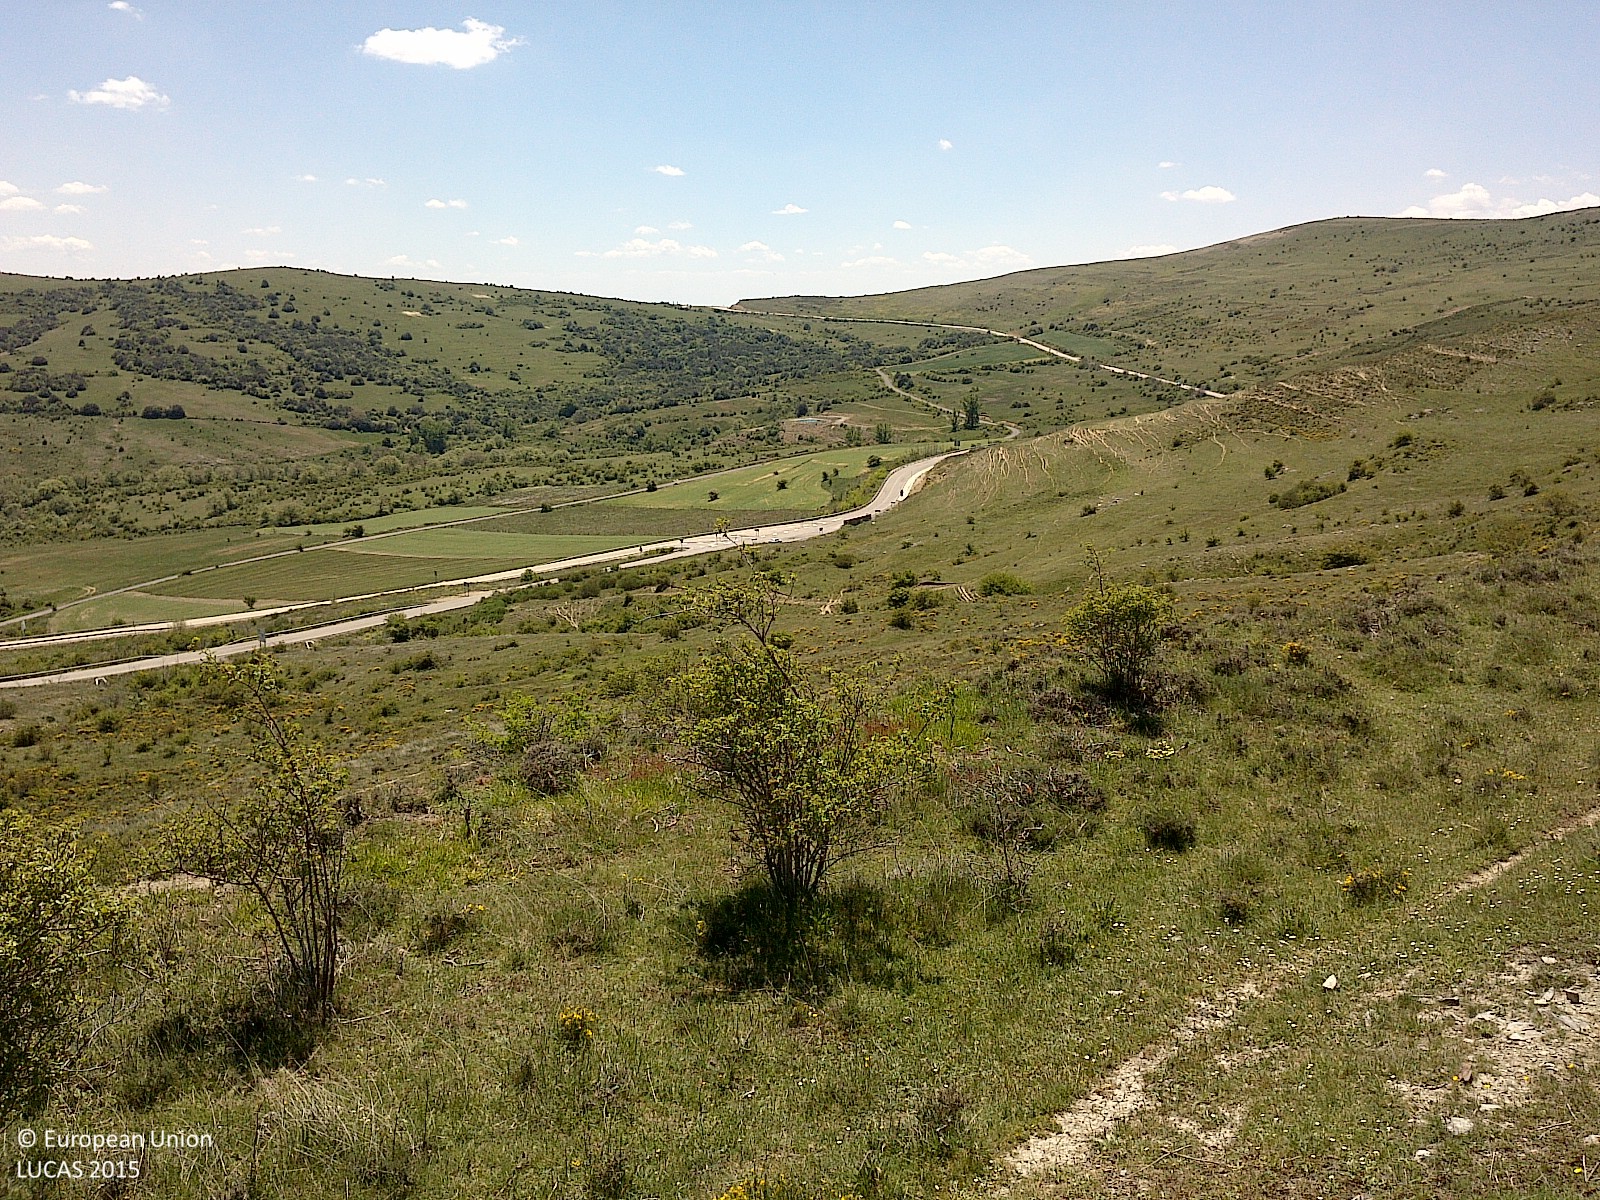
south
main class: Grassland
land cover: Grassland without tree/shrub cover
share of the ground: > 75 %
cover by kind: herbaceous plants 85 %, consolidated bare surface 10 %, shrubs 5 %
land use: Agriculture (excluding fallow land and kitchen gardens)
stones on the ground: < 10 %
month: May
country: ES
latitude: 41.9699
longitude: -2.3350
